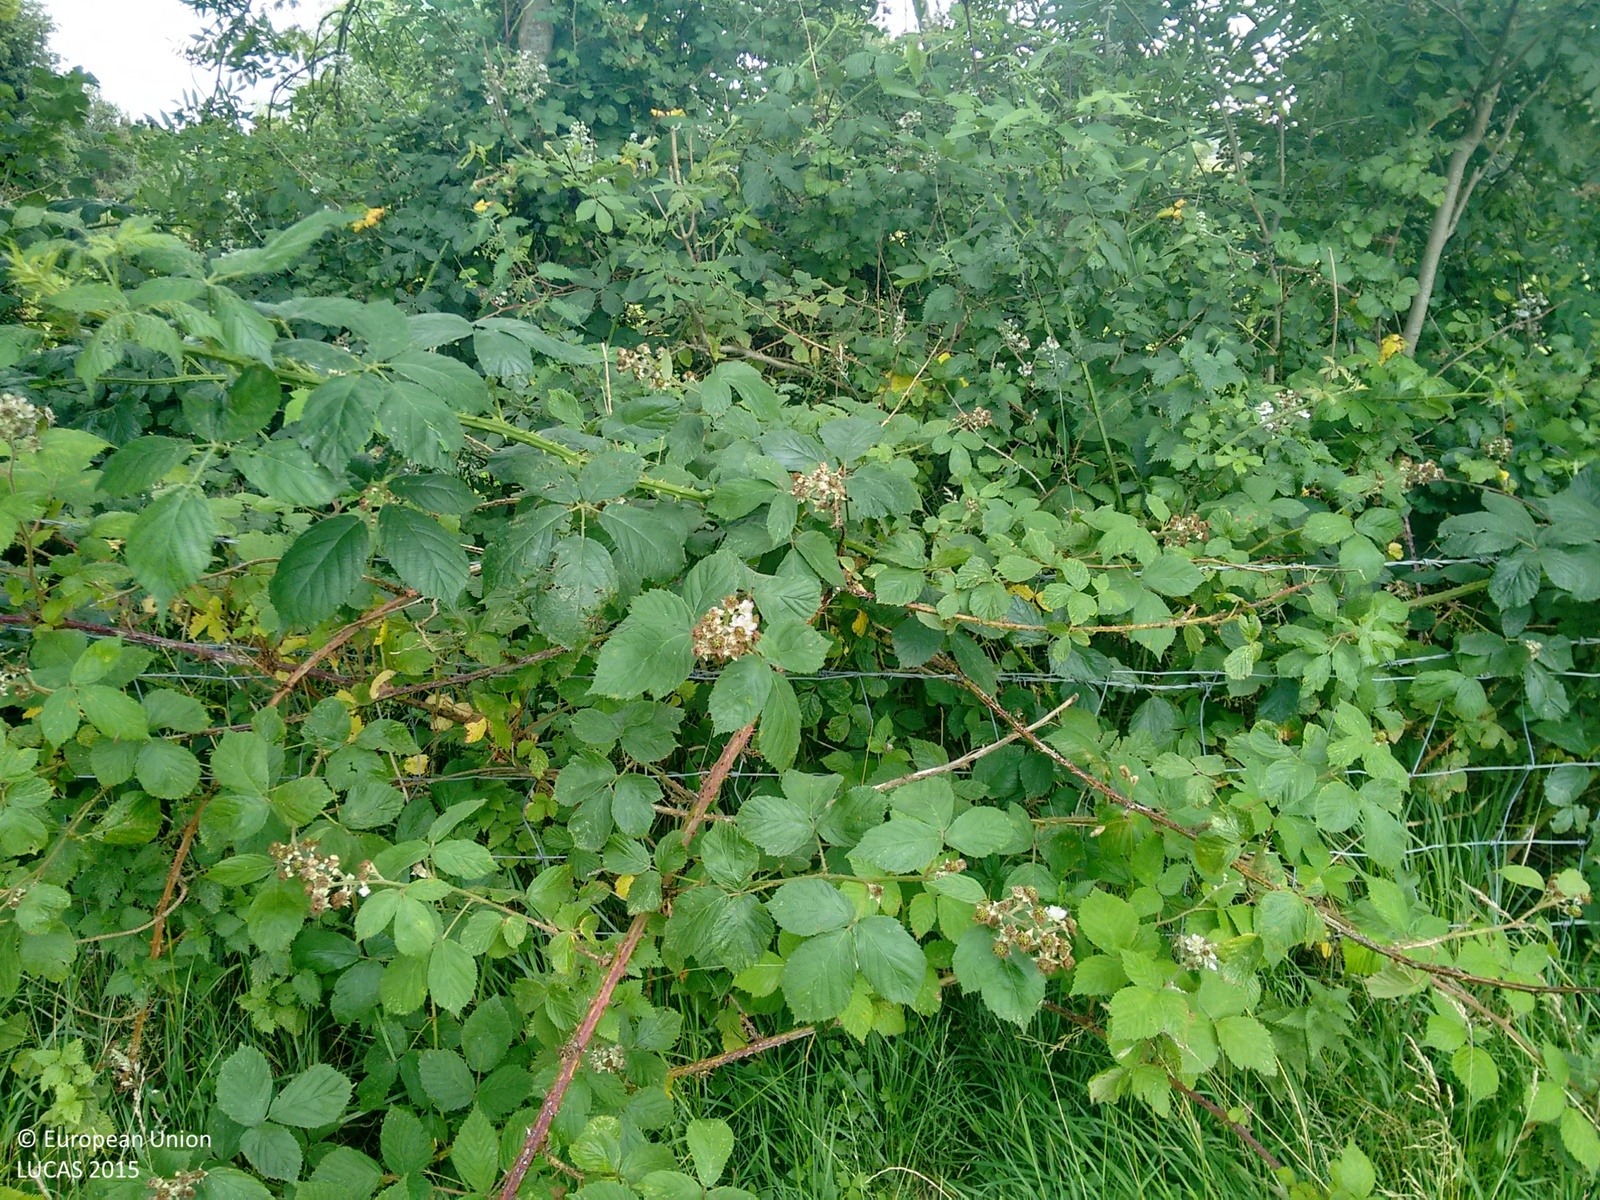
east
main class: Grassland
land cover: Grassland without tree/shrub cover
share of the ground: > 75 %
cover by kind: herbaceous plants 100 %
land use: Agriculture (excluding fallow land and kitchen gardens)
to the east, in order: Grassland without tree/shrub cover; Fences; Lines of trees; Grass margins; Rivers and streams; Grassland without tree/shrub cover; Abandoned hedges; Grassland without tree/shrub cover; Fences; Managed hedges; Grass margins; Paved roads, cycling and walking lanes; Grass margins; Electric lines; Managed hedges; Fences; Grassland without tree/shrub cover
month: August
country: GB
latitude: 54.3197
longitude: -6.7514
